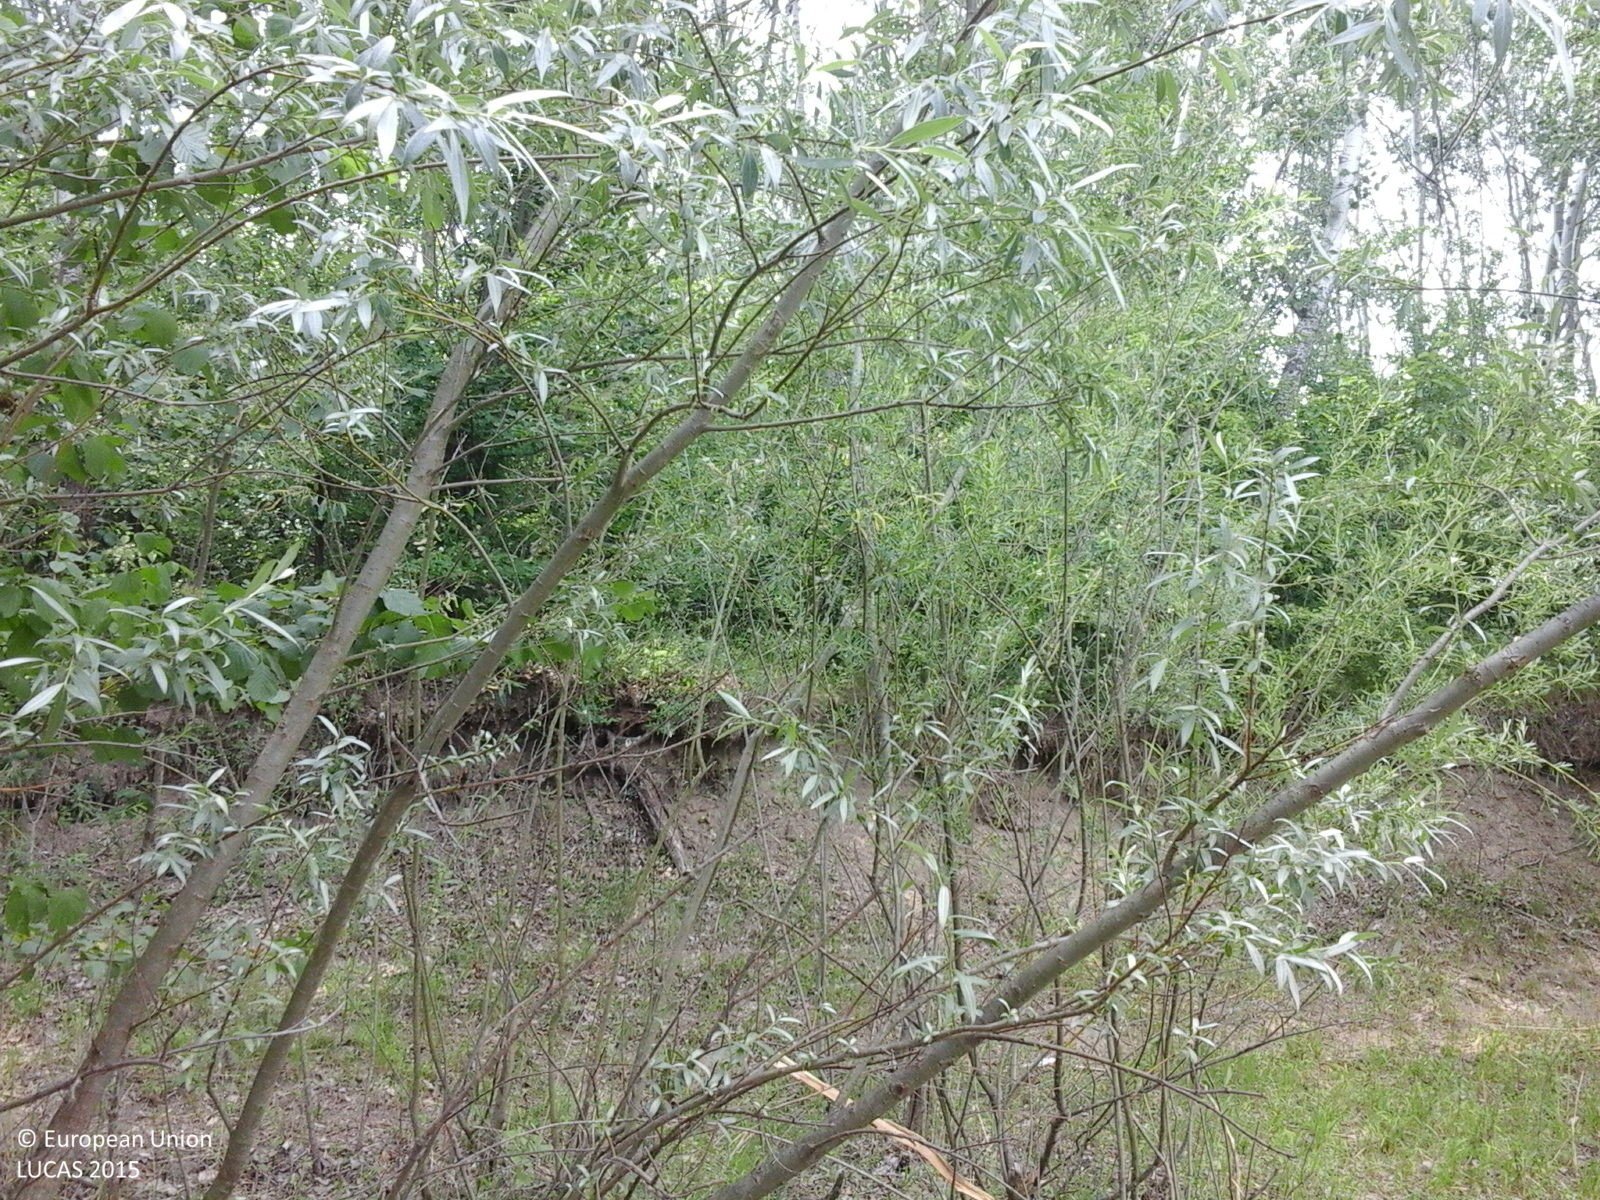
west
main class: Woodland
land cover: Broadleaved woodland
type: floodplain forest
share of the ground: > 75 %
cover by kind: broadleaved forest trees 85 %, shrubs 10 %, herbaceous plants 5 %
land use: Semi-natural and natural areas not in use
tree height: < 5 m
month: June
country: RO
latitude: 47.0413
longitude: 26.7415
